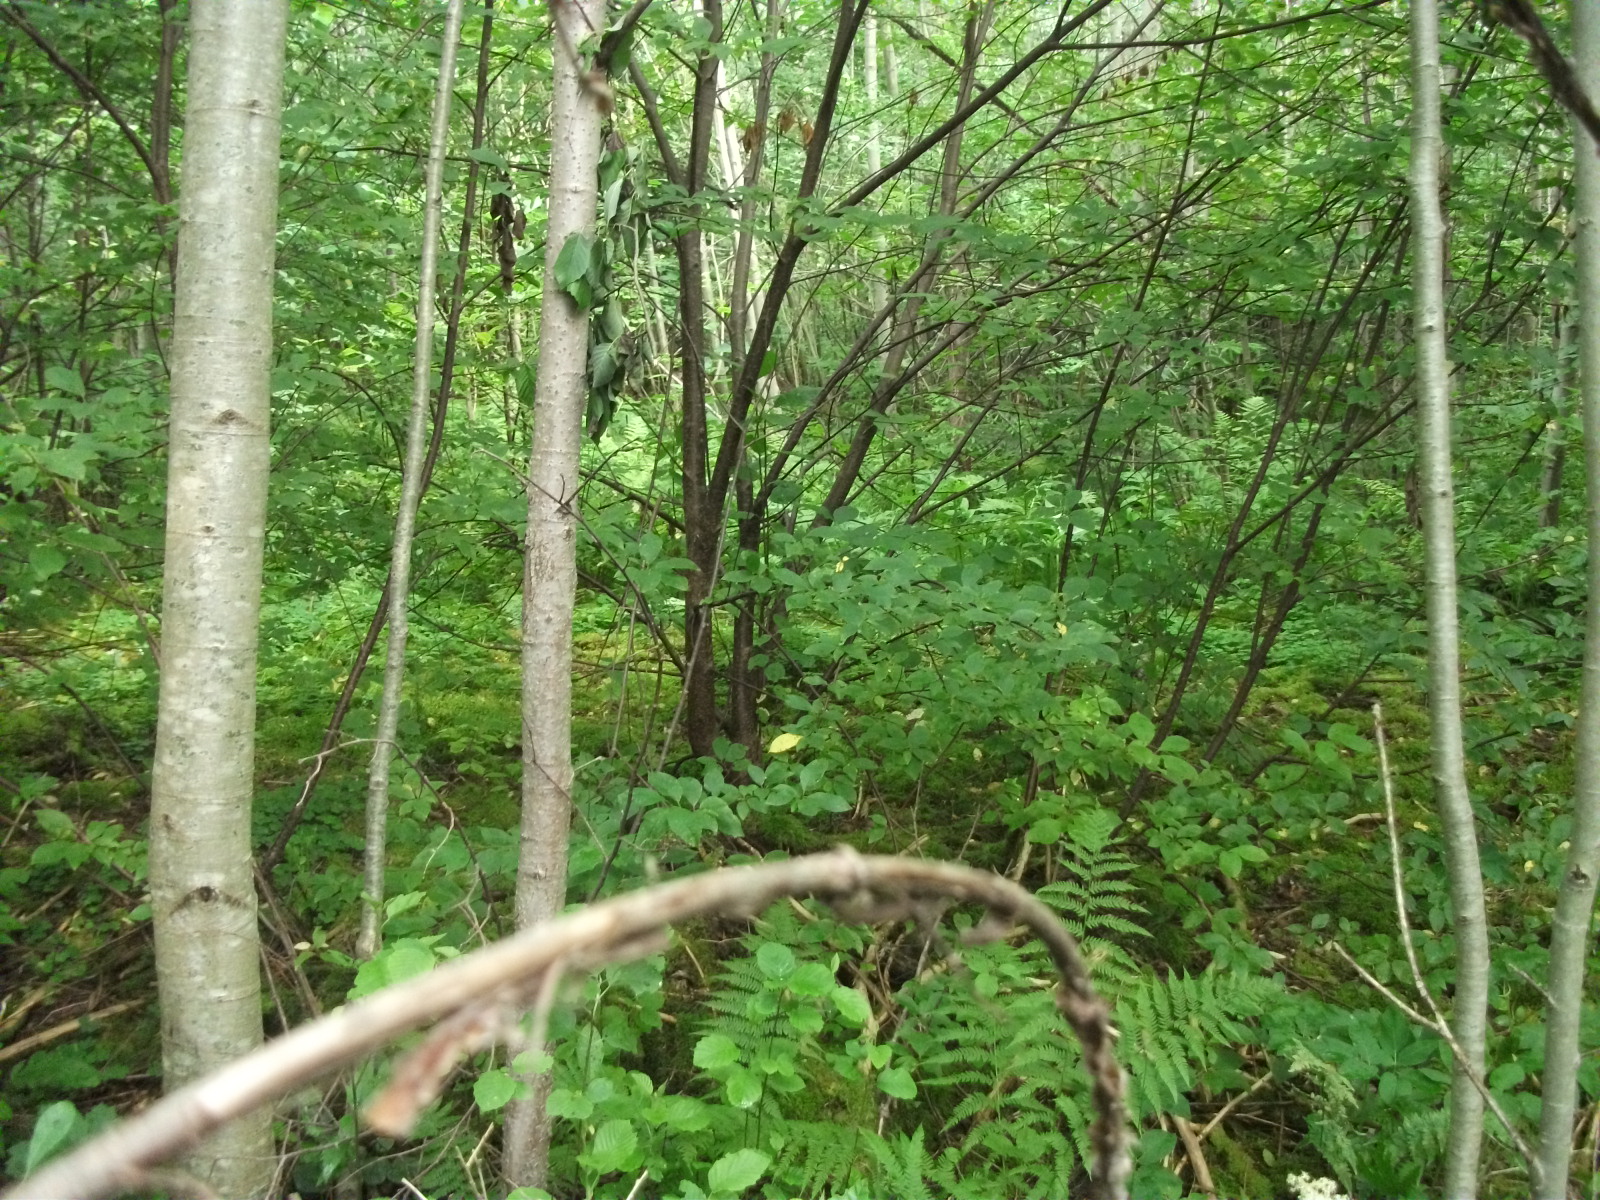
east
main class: Woodland
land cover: Broadleaved woodland
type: non-riverine alder, birch or aspen forest
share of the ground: > 75 %
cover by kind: broadleaved forest trees 90 %, shrubs 5 %, herbaceous plants 5 %
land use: Forestry
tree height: > 5 m
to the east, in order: Broadleaved woodland; Grassland without tree/shrub cover; Broadleaved woodland; Ditches and canals; Broadleaved woodland; Shruby margins; Fences; Grassland without tree/shrub cover
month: July
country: LV
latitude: 57.1219
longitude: 26.4451
